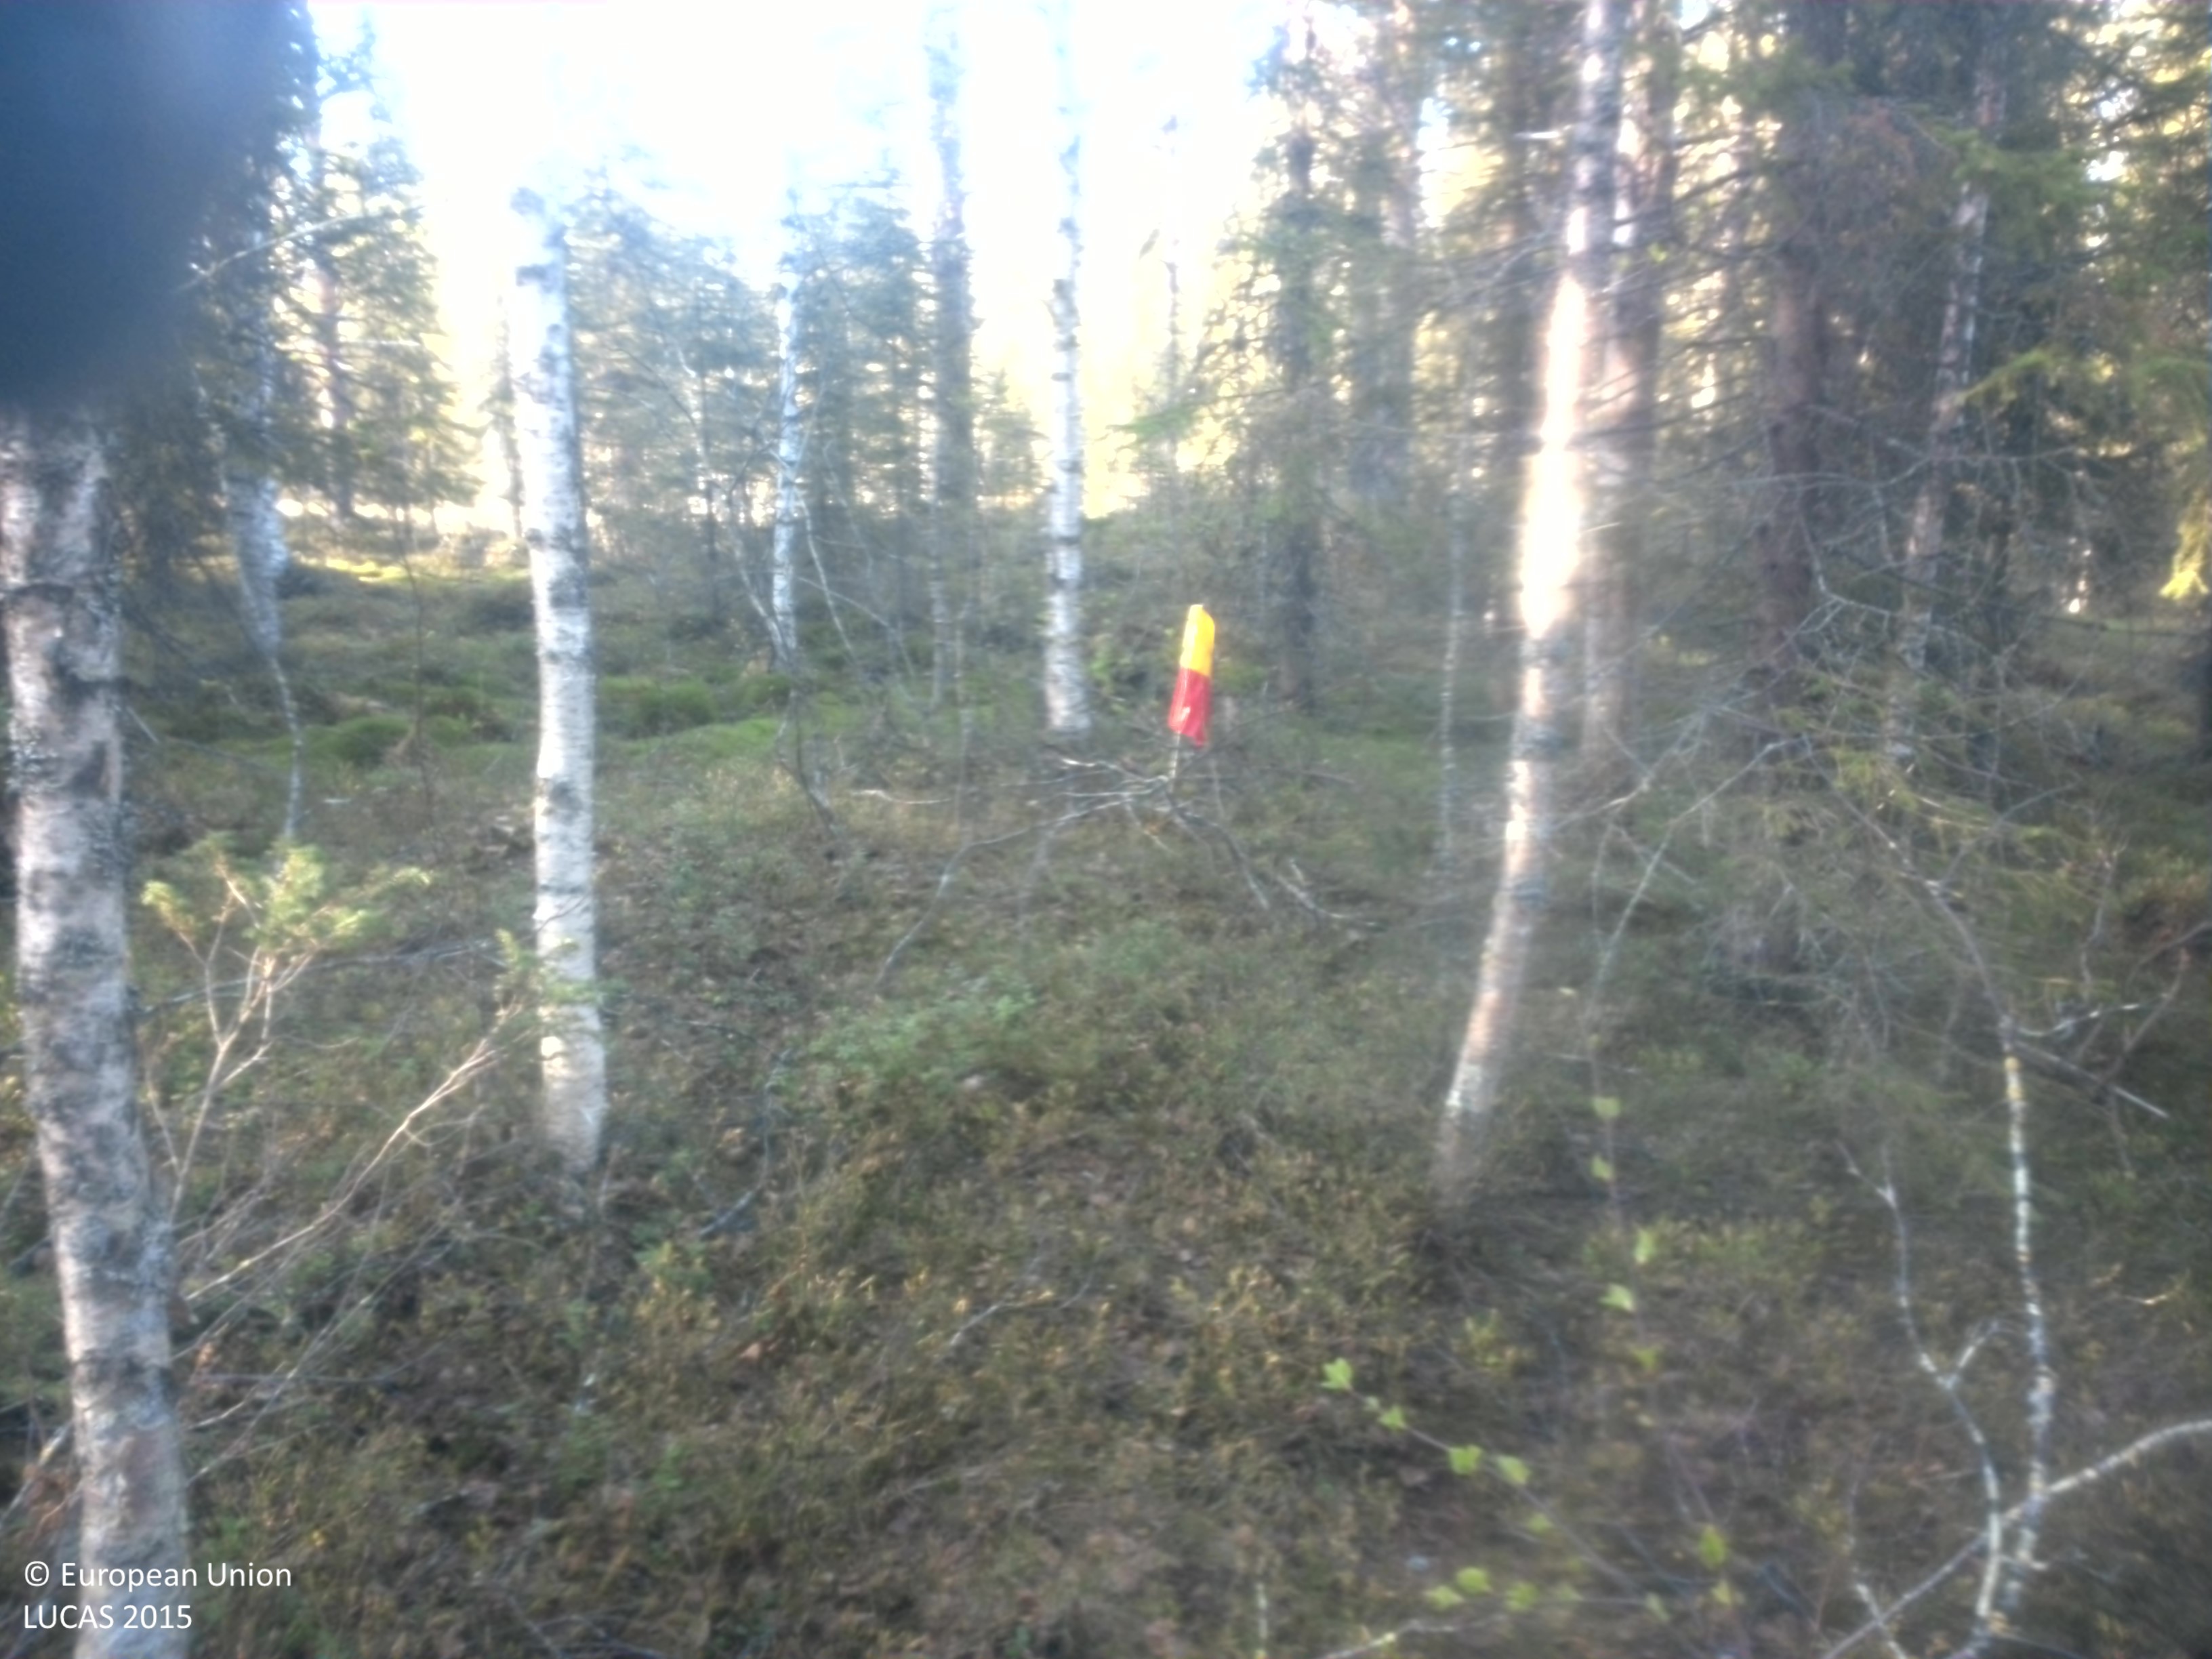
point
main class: Woodland
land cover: Spruce dominated mixed woodland
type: boreal forest
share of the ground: 25 - 50 %
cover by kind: coniferous forest trees 35 %, herbaceous plants 20 %, lichens and mosses 20 %, broadleaved forest trees 15 %, shrubs 5 %
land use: Forestry
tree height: > 5 m
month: June
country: SE
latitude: 64.4622
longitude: 17.7638
